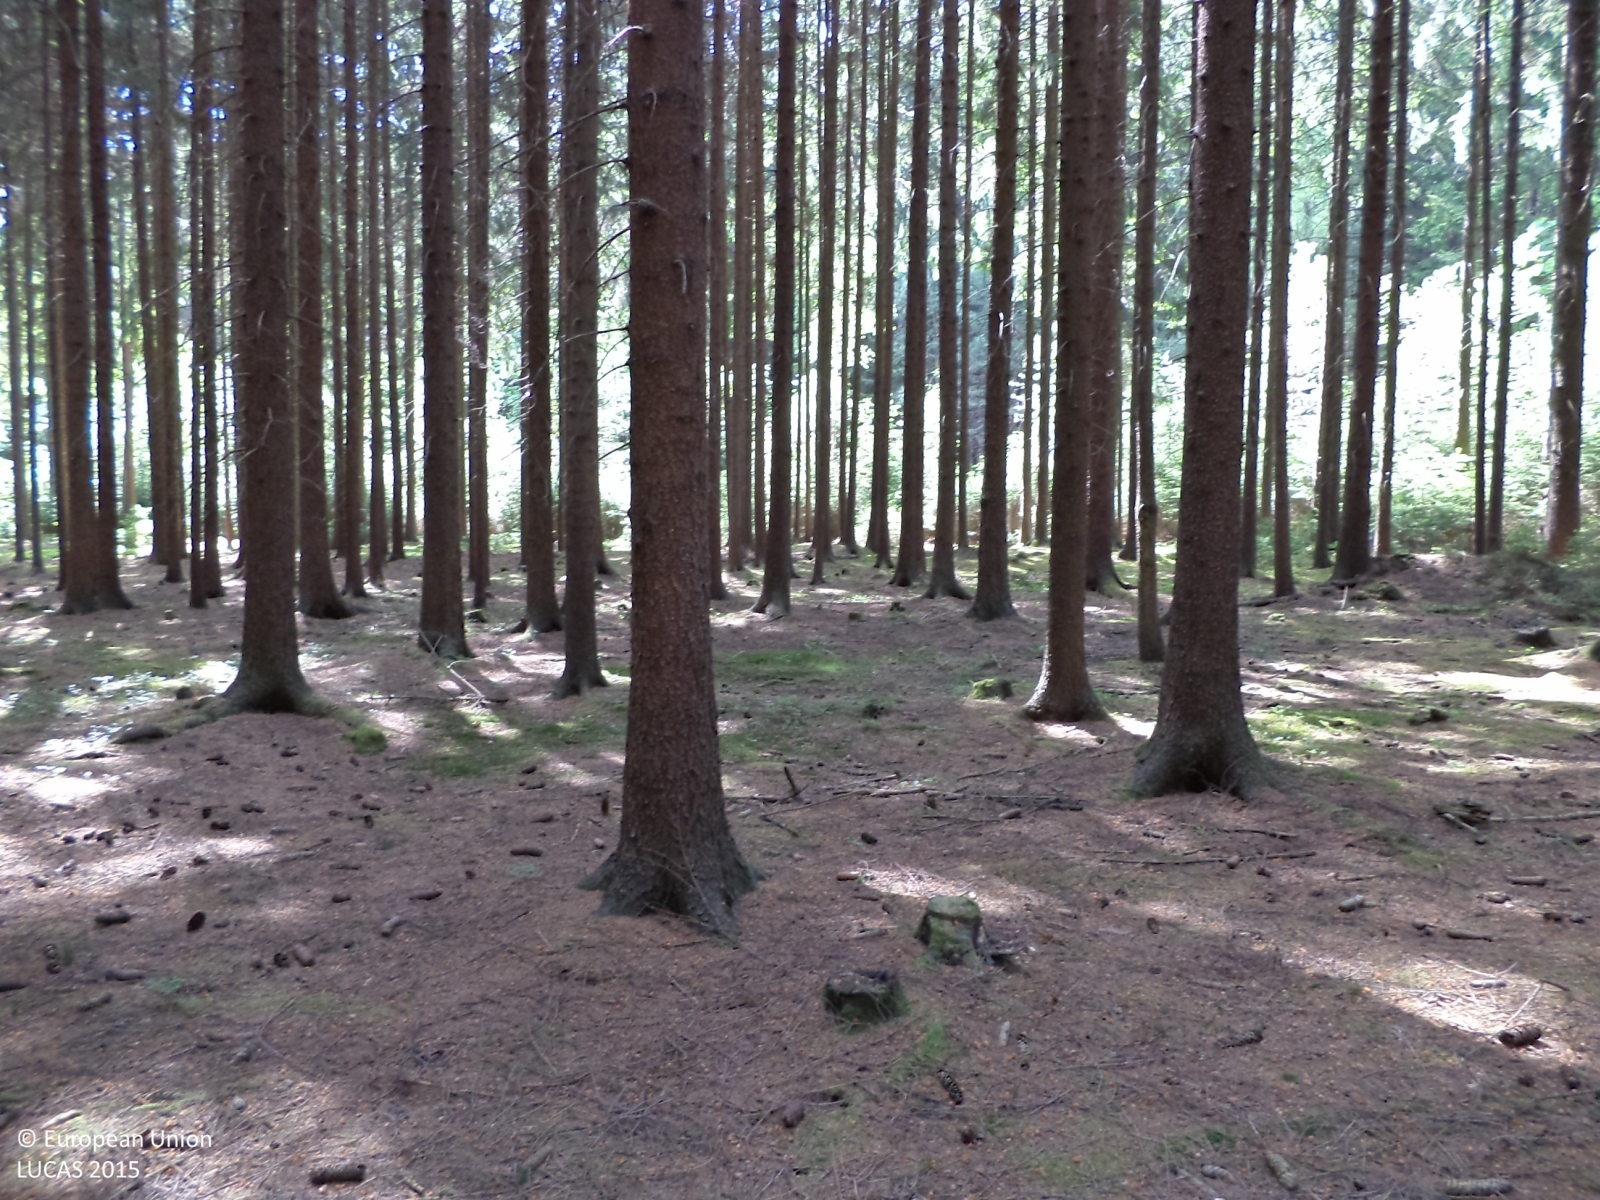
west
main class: Woodland
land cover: Spruce dominated coniferous woodland
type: hemiboreal forest and nemoral coniferous forest and mixed broadleaved-coniferous forest
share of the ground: > 75 %
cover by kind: coniferous forest trees 95 %, lichens and mosses 5 %
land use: Forestry
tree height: > 5 m
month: June
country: CZ
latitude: 49.6192
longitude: 15.1104
